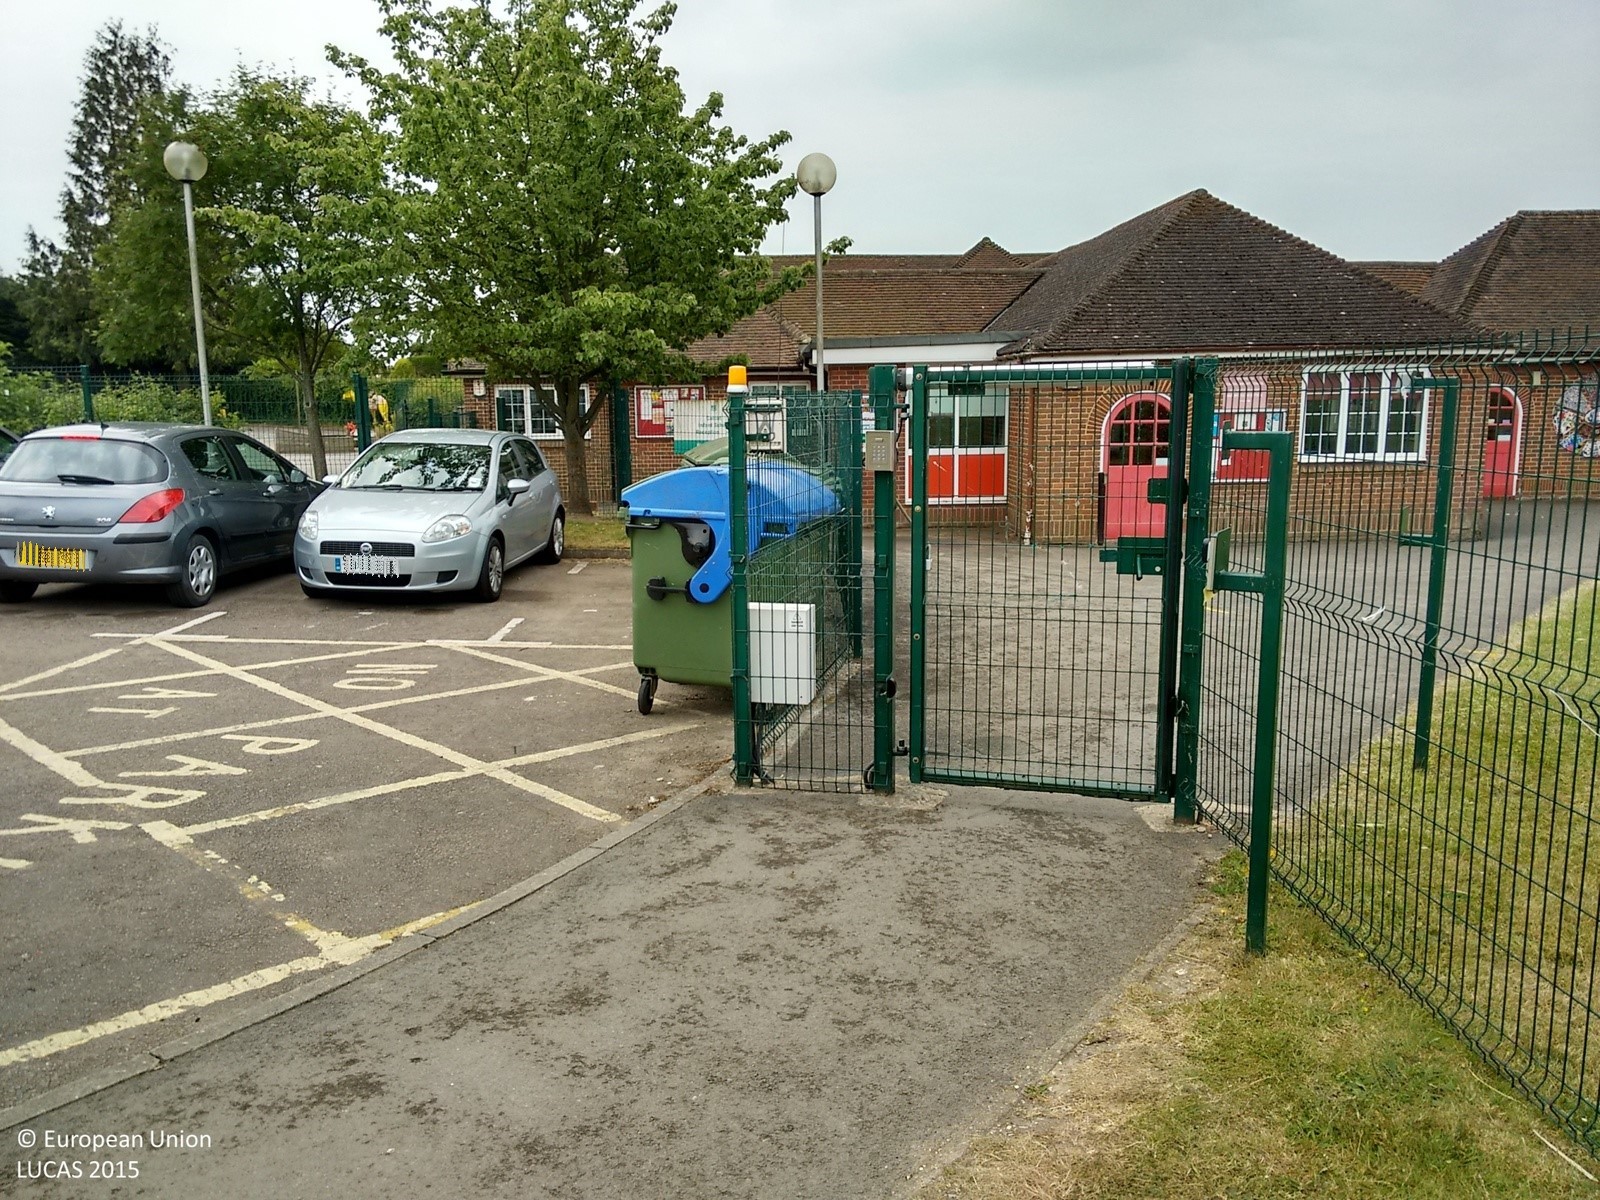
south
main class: Grassland
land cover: Grassland without tree/shrub cover
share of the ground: > 75 %
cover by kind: herbaceous plants 100 %
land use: Community services
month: June
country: GB
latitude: 51.4422
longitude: -1.0514
